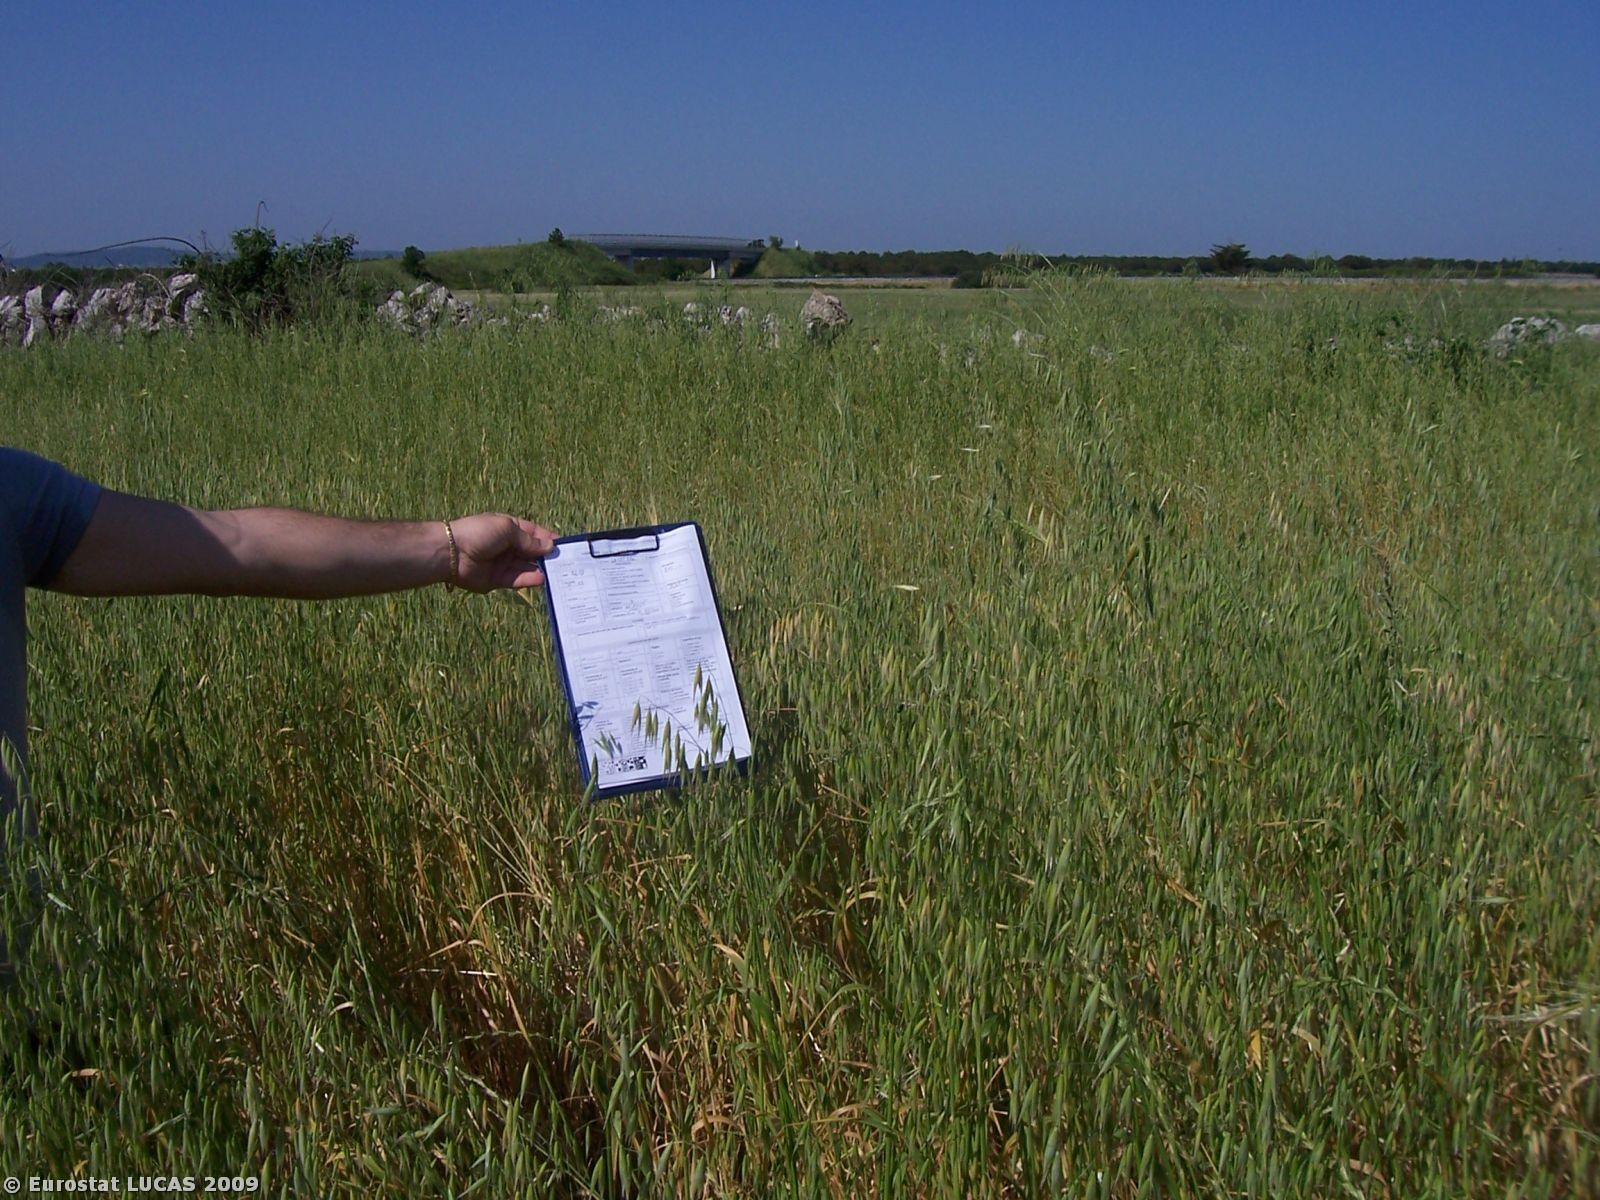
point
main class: Cropland
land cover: Oats
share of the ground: > 75 %
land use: Agriculture (excluding fallow land and kitchen gardens)
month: May
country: IT
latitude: 40.7122
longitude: 16.9254
